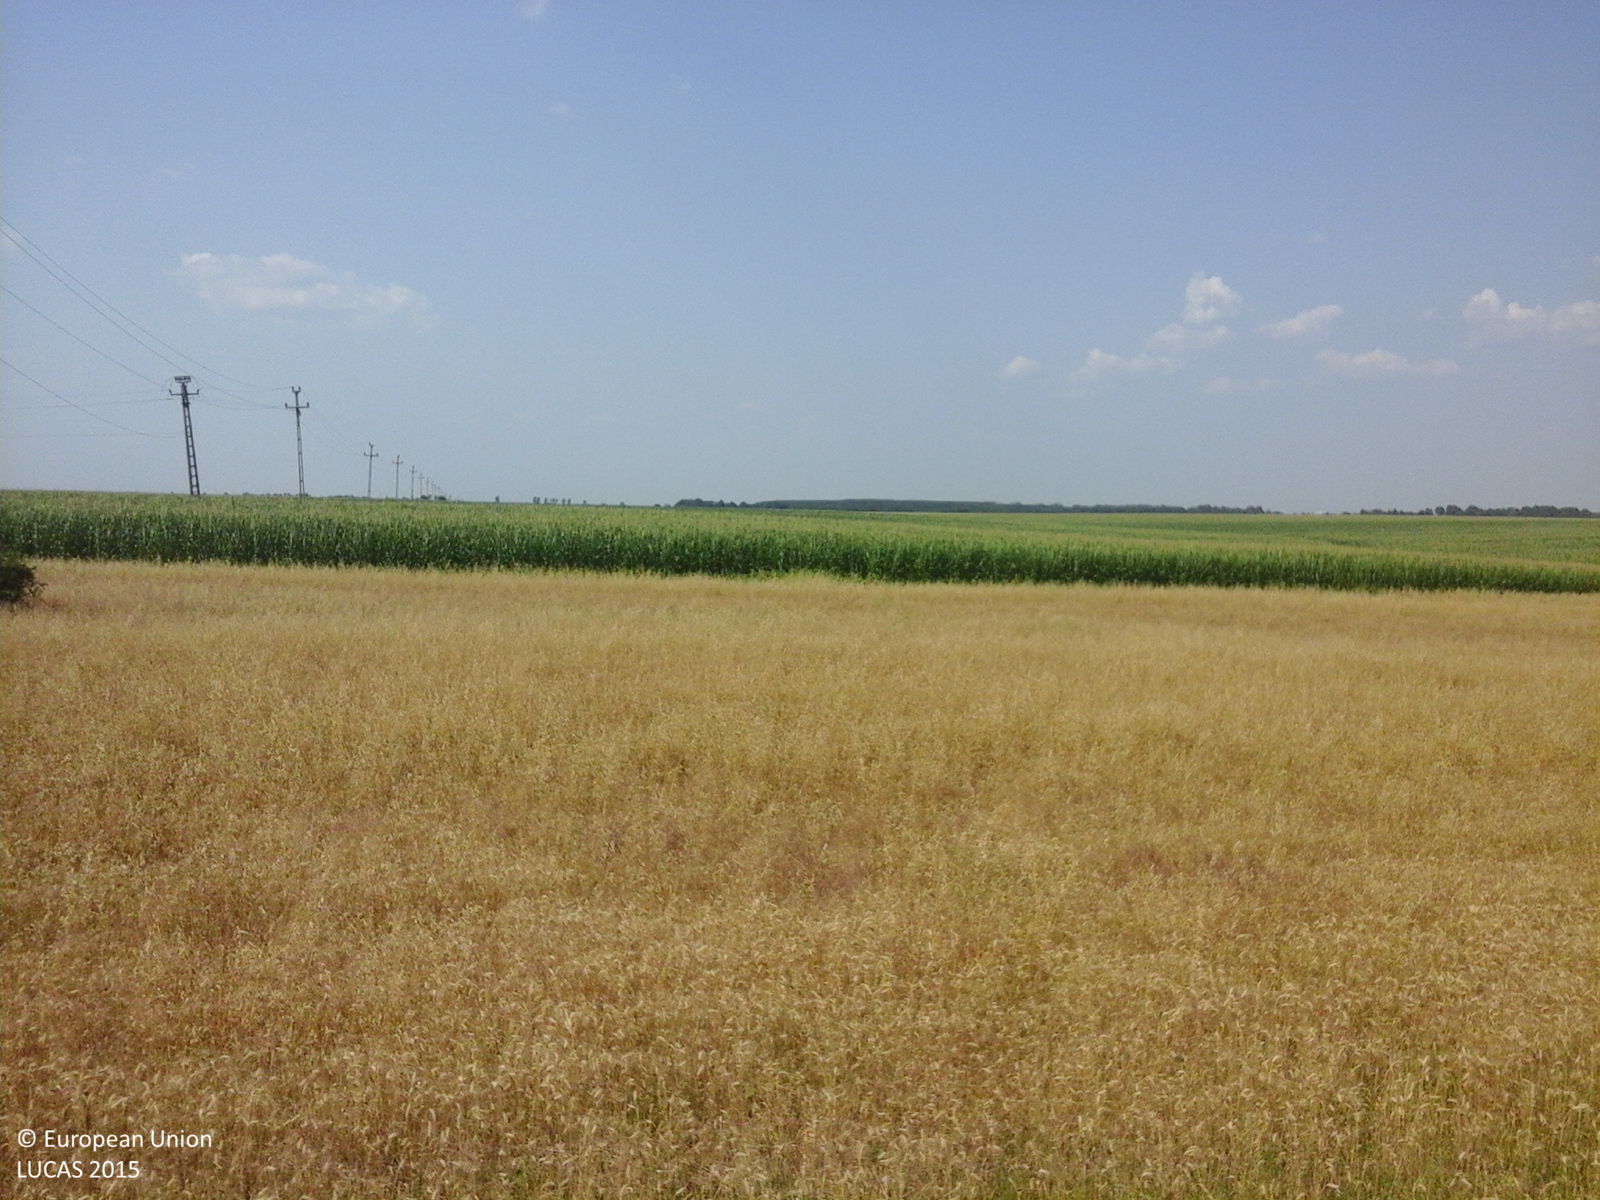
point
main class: Cropland
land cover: Maize
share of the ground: > 75 %
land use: Agriculture (excluding fallow land and kitchen gardens)
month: July
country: RO
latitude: 44.6598
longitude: 24.5129
